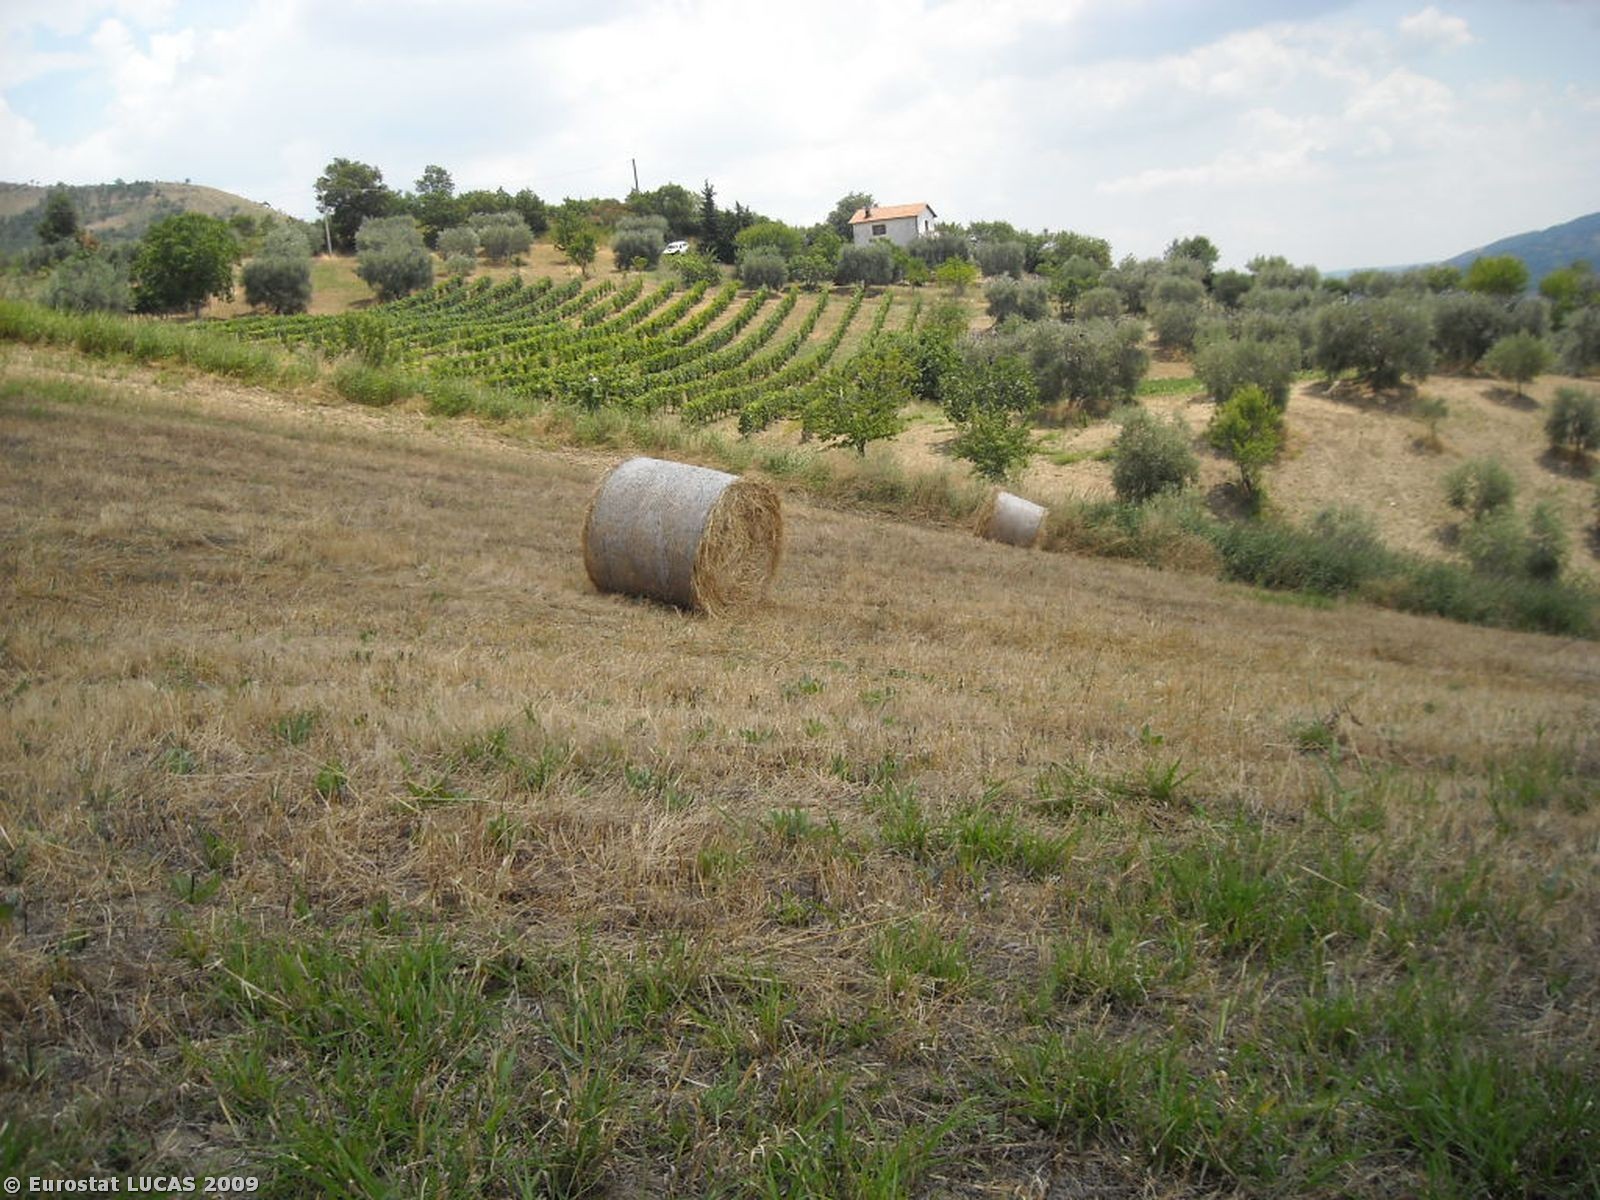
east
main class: Cropland
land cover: Mixed cereals for fodder
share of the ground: < 10 %
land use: Agriculture (excluding fallow land and kitchen gardens)
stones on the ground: < 10 %
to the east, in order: Mixed cereals for fodder; Grass margins; Ditches and canals; Grass margins; Fences; Olive groves; Spontaneously vegetated surfaces; Other fresh vegetables; Olive groves; Spontaneously vegetated surfaces; Other fruit trees and berries; Spontaneously vegetated surfaces; Olive groves; Spontaneously vegetated surfaces; Artificial constructions in urban areas; Managed hedges; Fences; Grass margins; Paved roads, cycling and walking lanes; Shrubland without tree cover
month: July
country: IT
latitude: 40.6014
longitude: 16.1339
